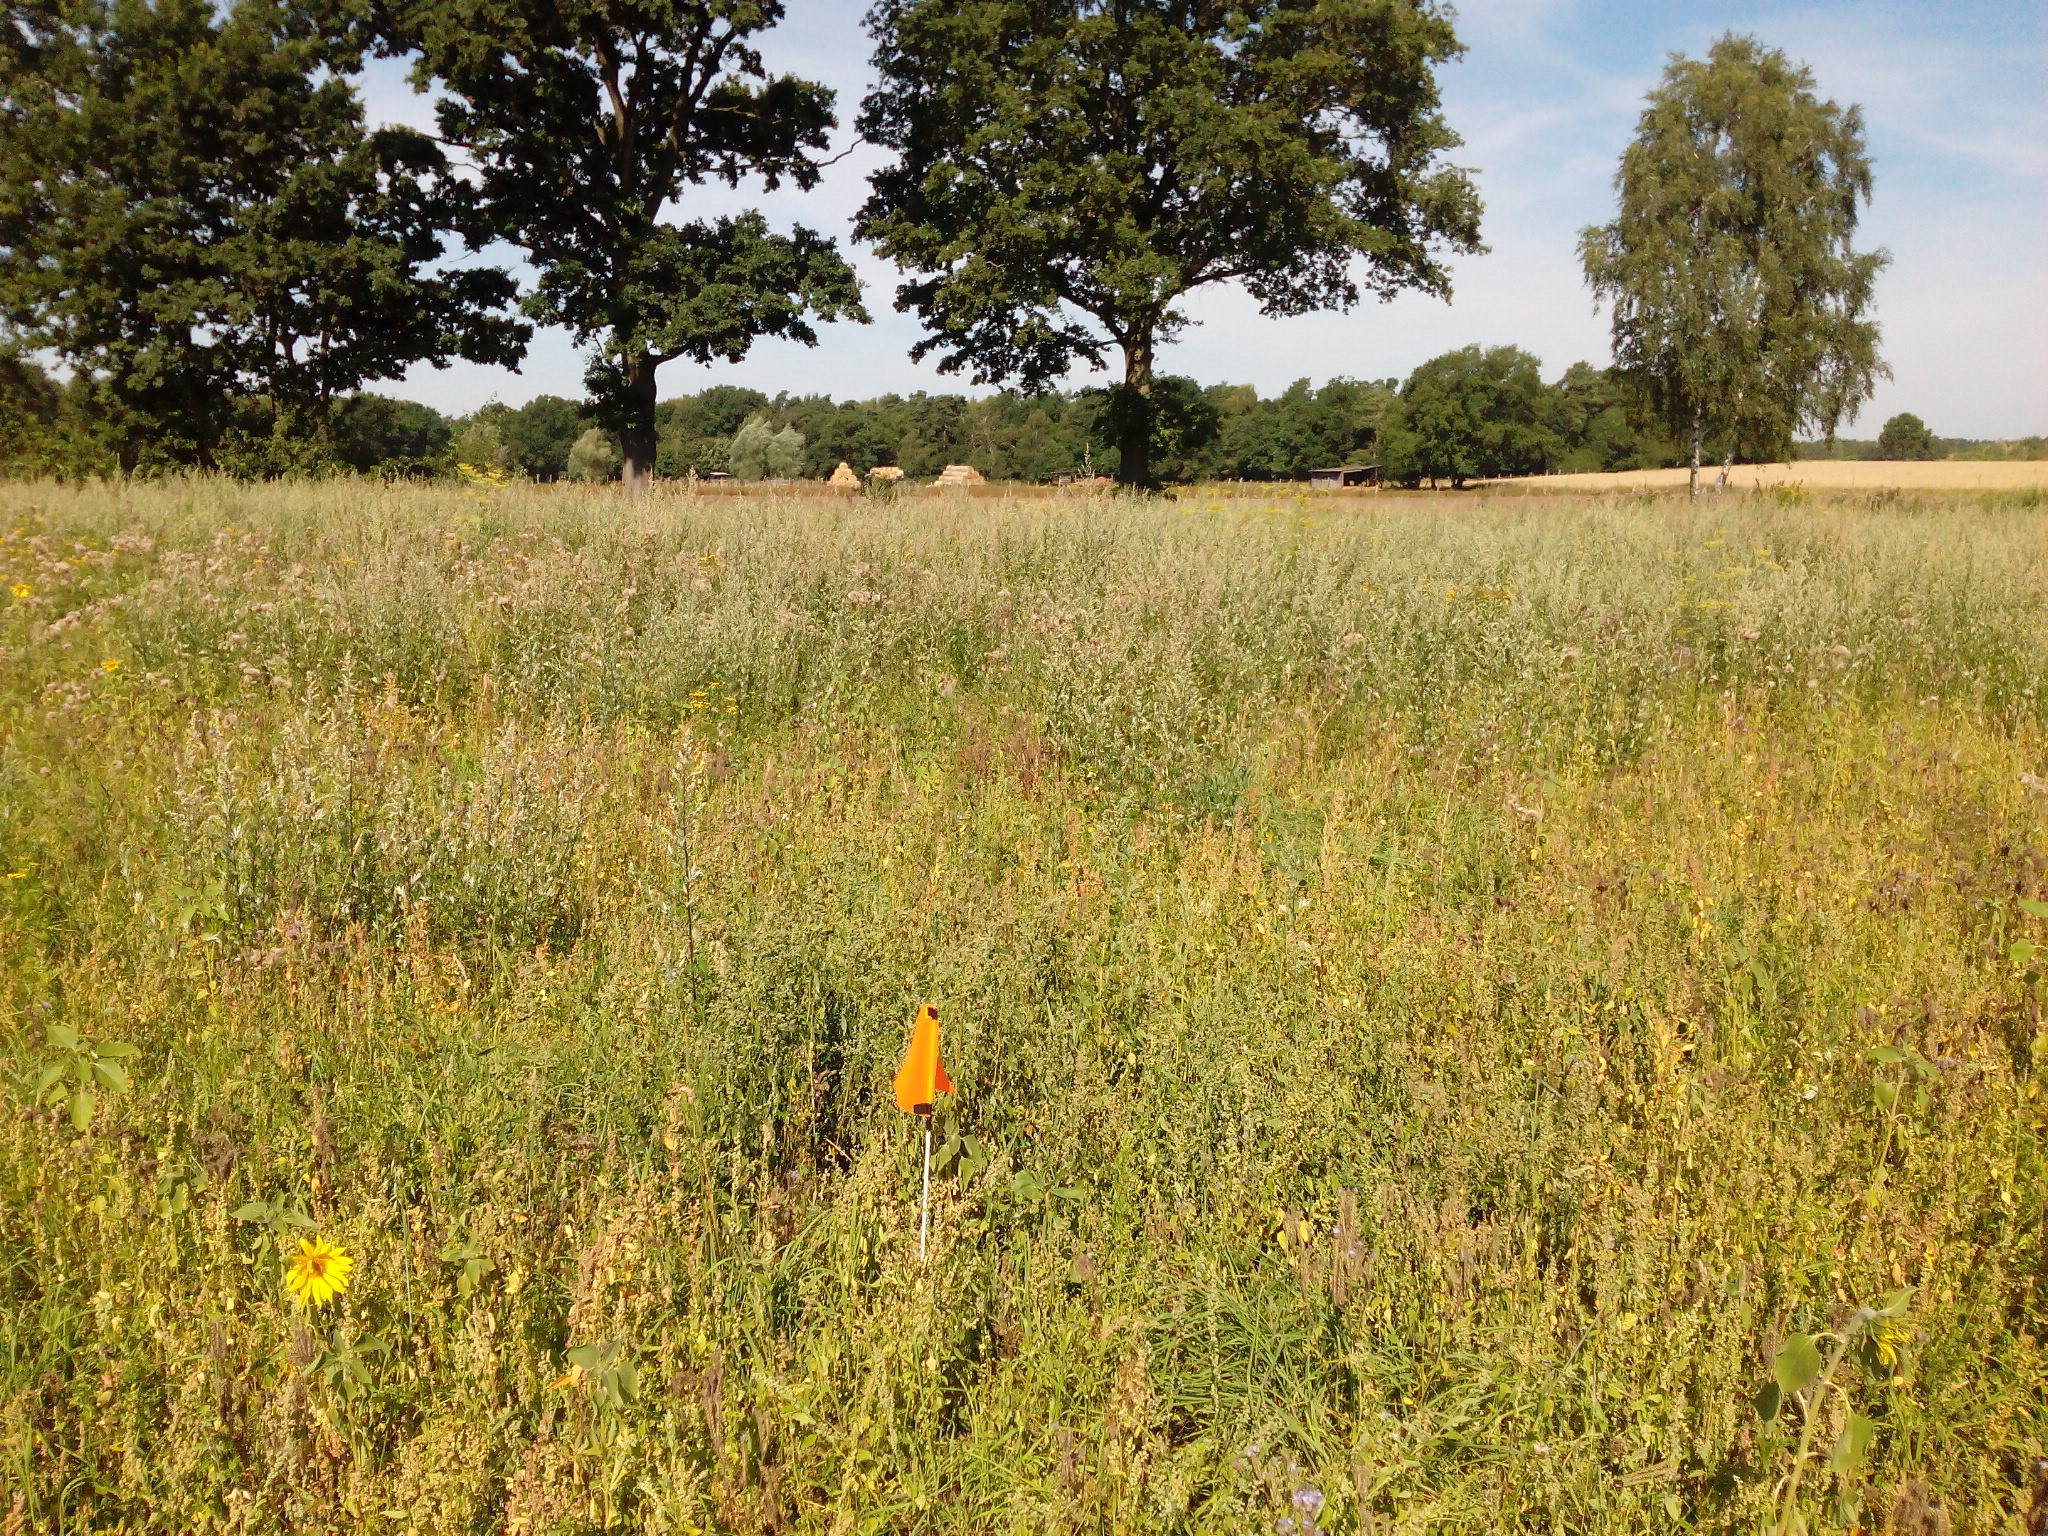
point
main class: Grassland
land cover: Grassland without tree/shrub cover
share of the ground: > 75 %
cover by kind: herbaceous plants 100 %
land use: Agriculture (excluding fallow land and kitchen gardens)
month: August
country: DE
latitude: 52.4853
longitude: 9.9264
